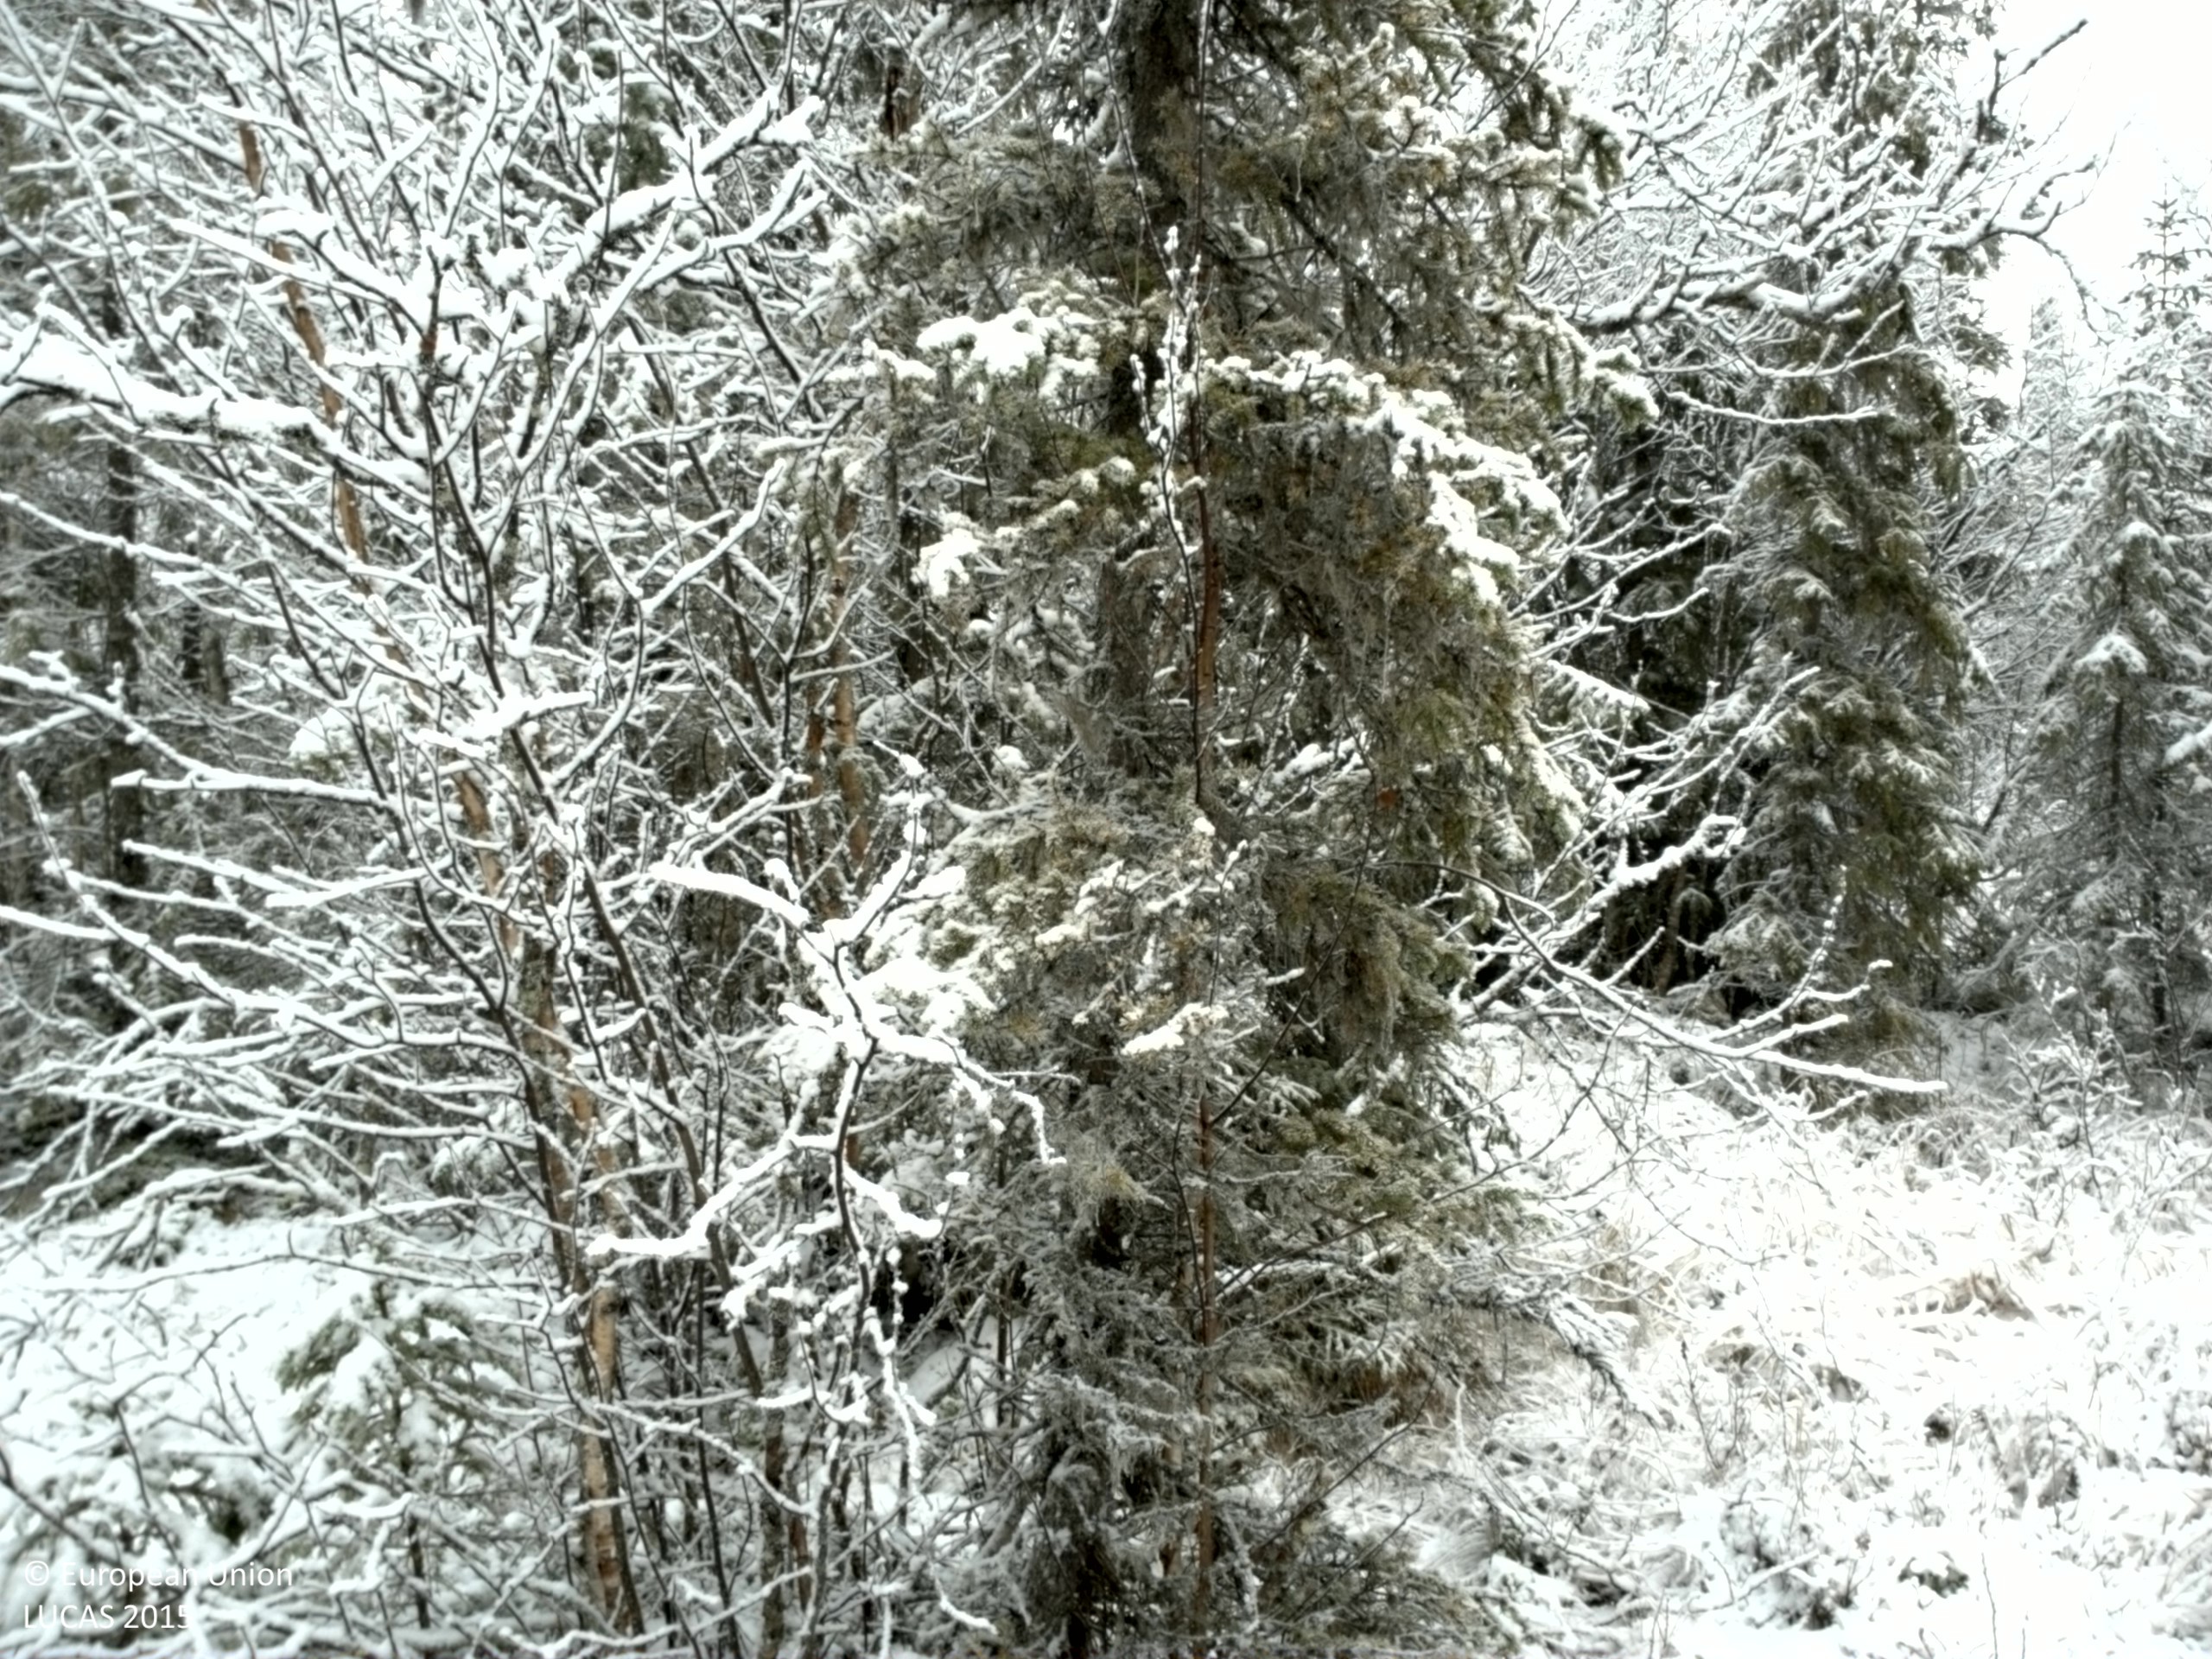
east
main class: Woodland
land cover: Spruce dominated mixed woodland
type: exotic forest
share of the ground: 50 - 75 %
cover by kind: shrubs 35 %, coniferous forest trees 30 %, broadleaved forest trees 20 %, lichens and mosses 15 %
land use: Forestry
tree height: > 5 m
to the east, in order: Spruce dominated mixed woodland; Ditches and canals; Spruce dominated mixed woodland; Spruce dominated coniferous woodland; Spruce dominated mixed woodland
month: November
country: SE
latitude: 63.7292
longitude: 15.3407
